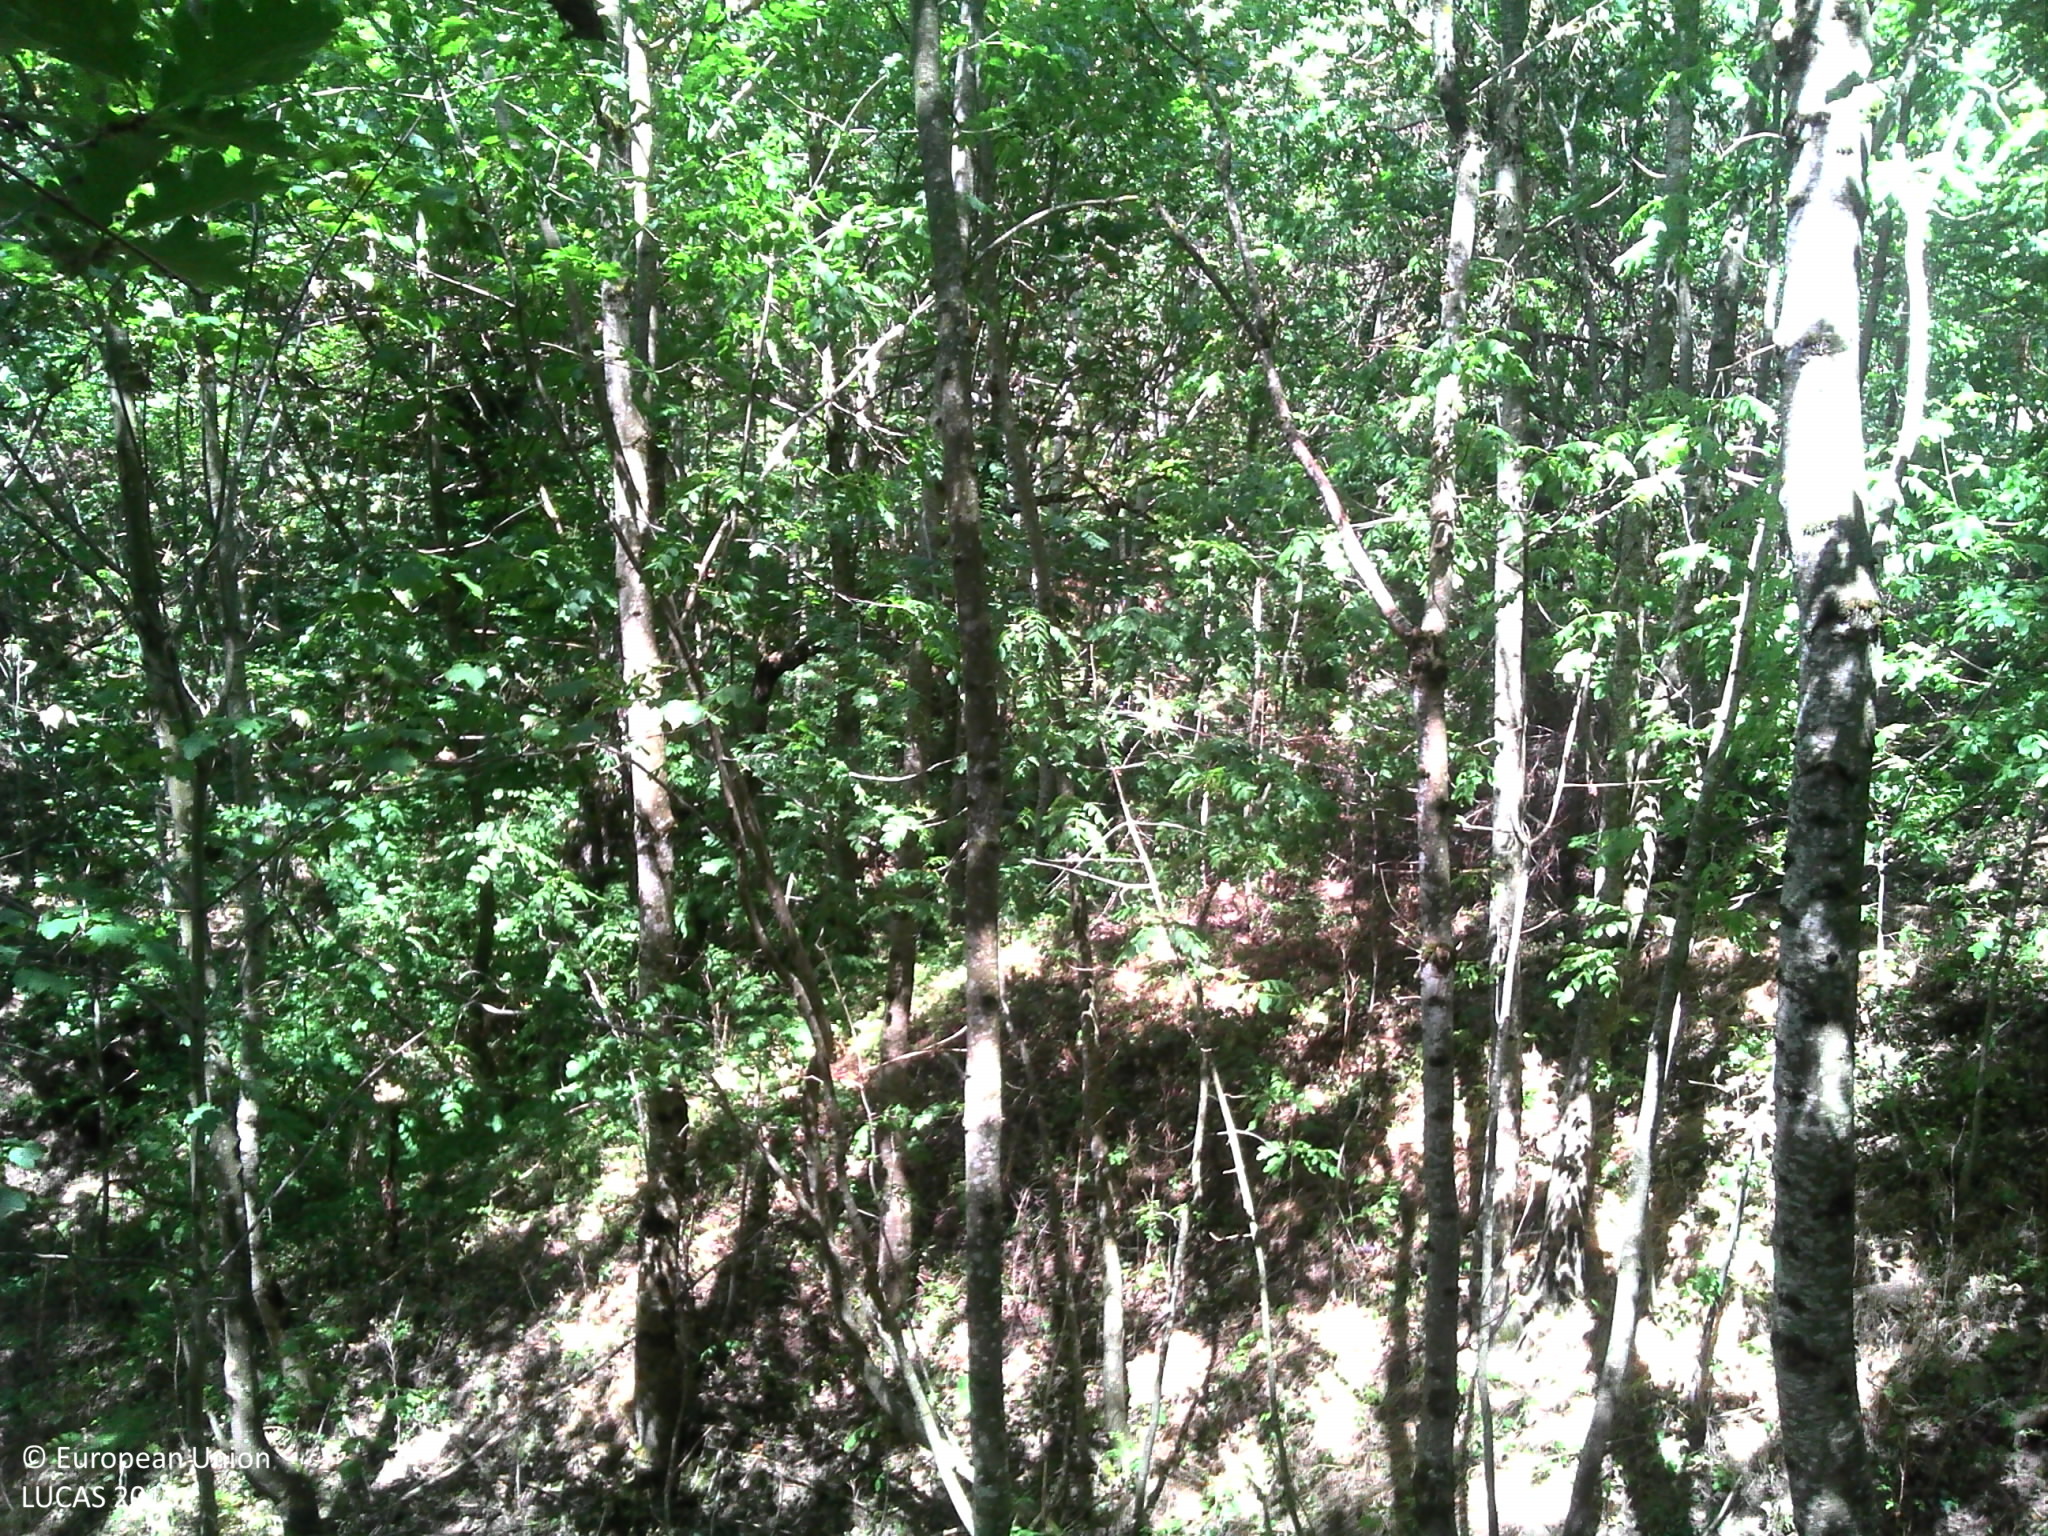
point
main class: Woodland
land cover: Broadleaved woodland
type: broadleaved evergreen forest
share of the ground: > 75 %
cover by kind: broadleaved forest trees 100 %
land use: Forestry
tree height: > 5 m
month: July
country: FR
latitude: 44.9710
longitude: 4.6420
